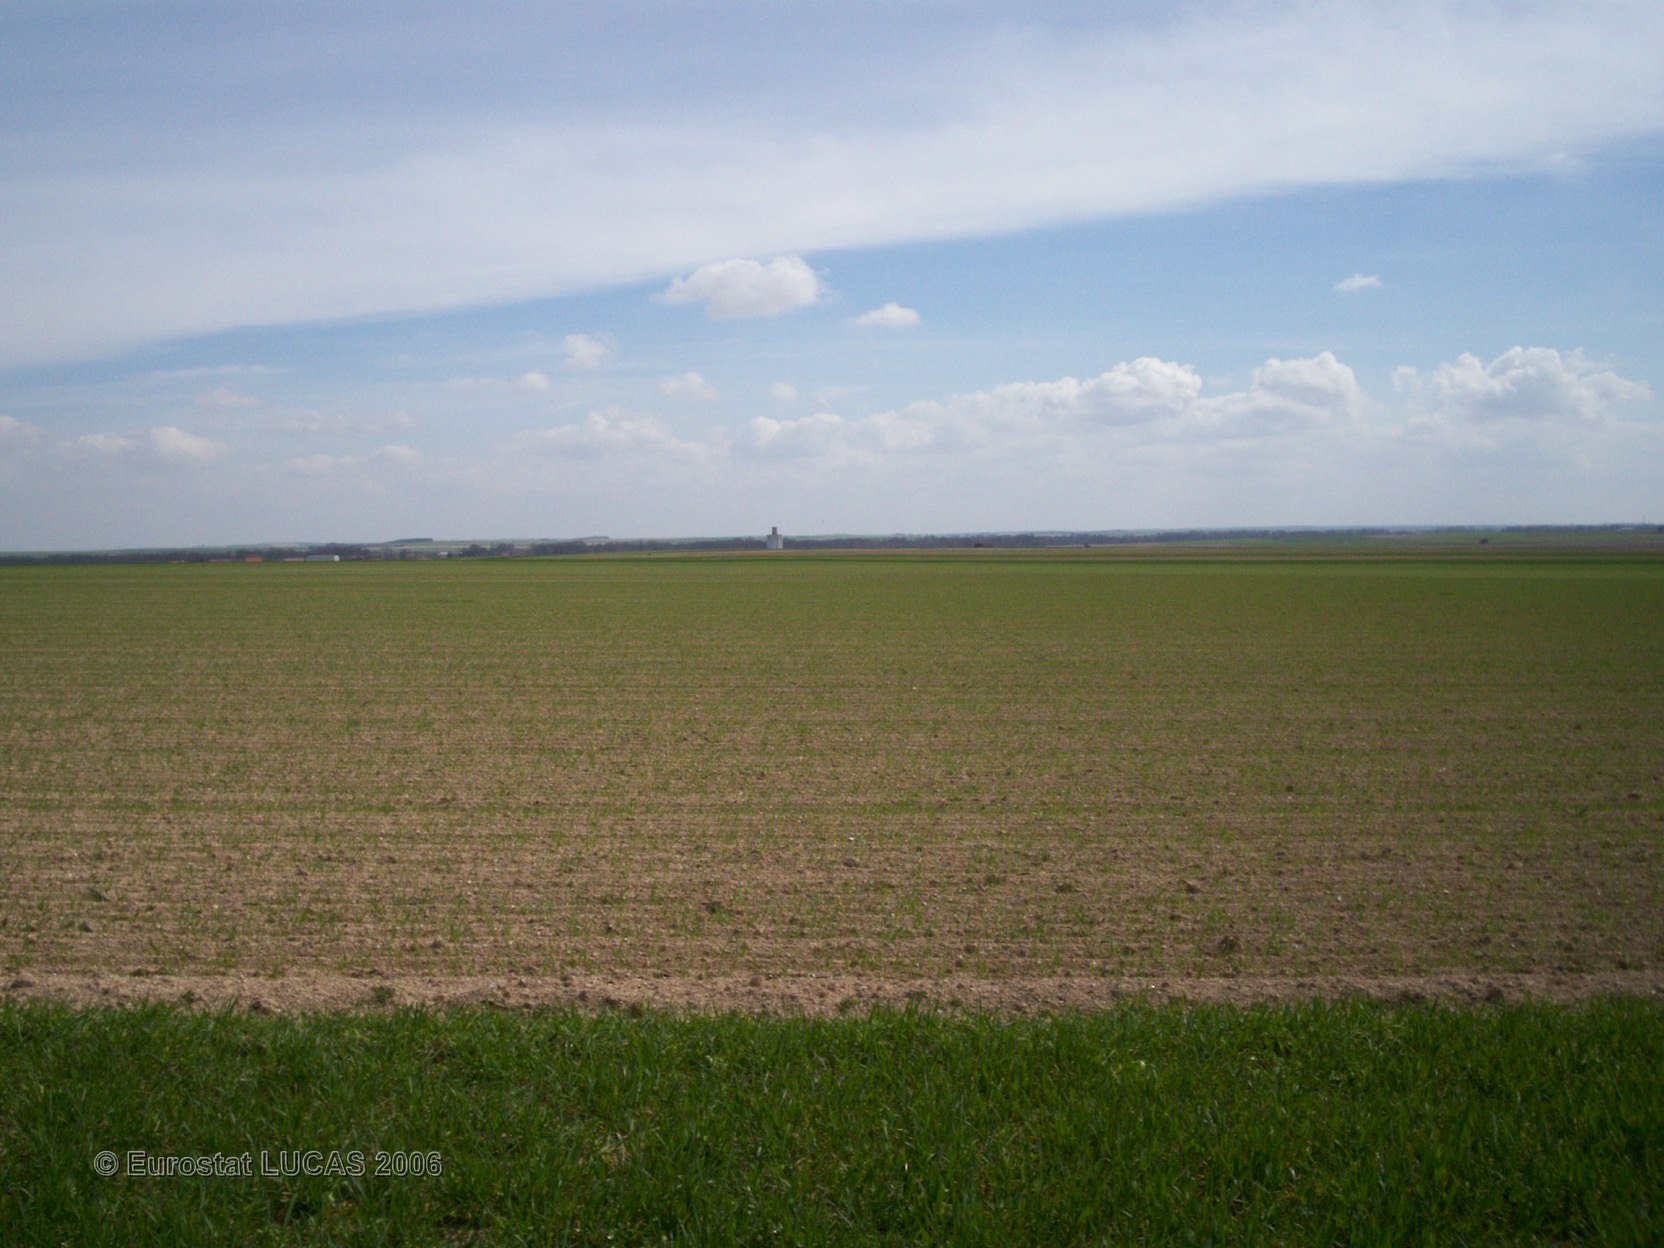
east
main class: Cropland
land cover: Barley
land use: Agriculture (excluding fallow land and kitchen gardens)
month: April
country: FR
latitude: 49.1985
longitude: 4.3832
